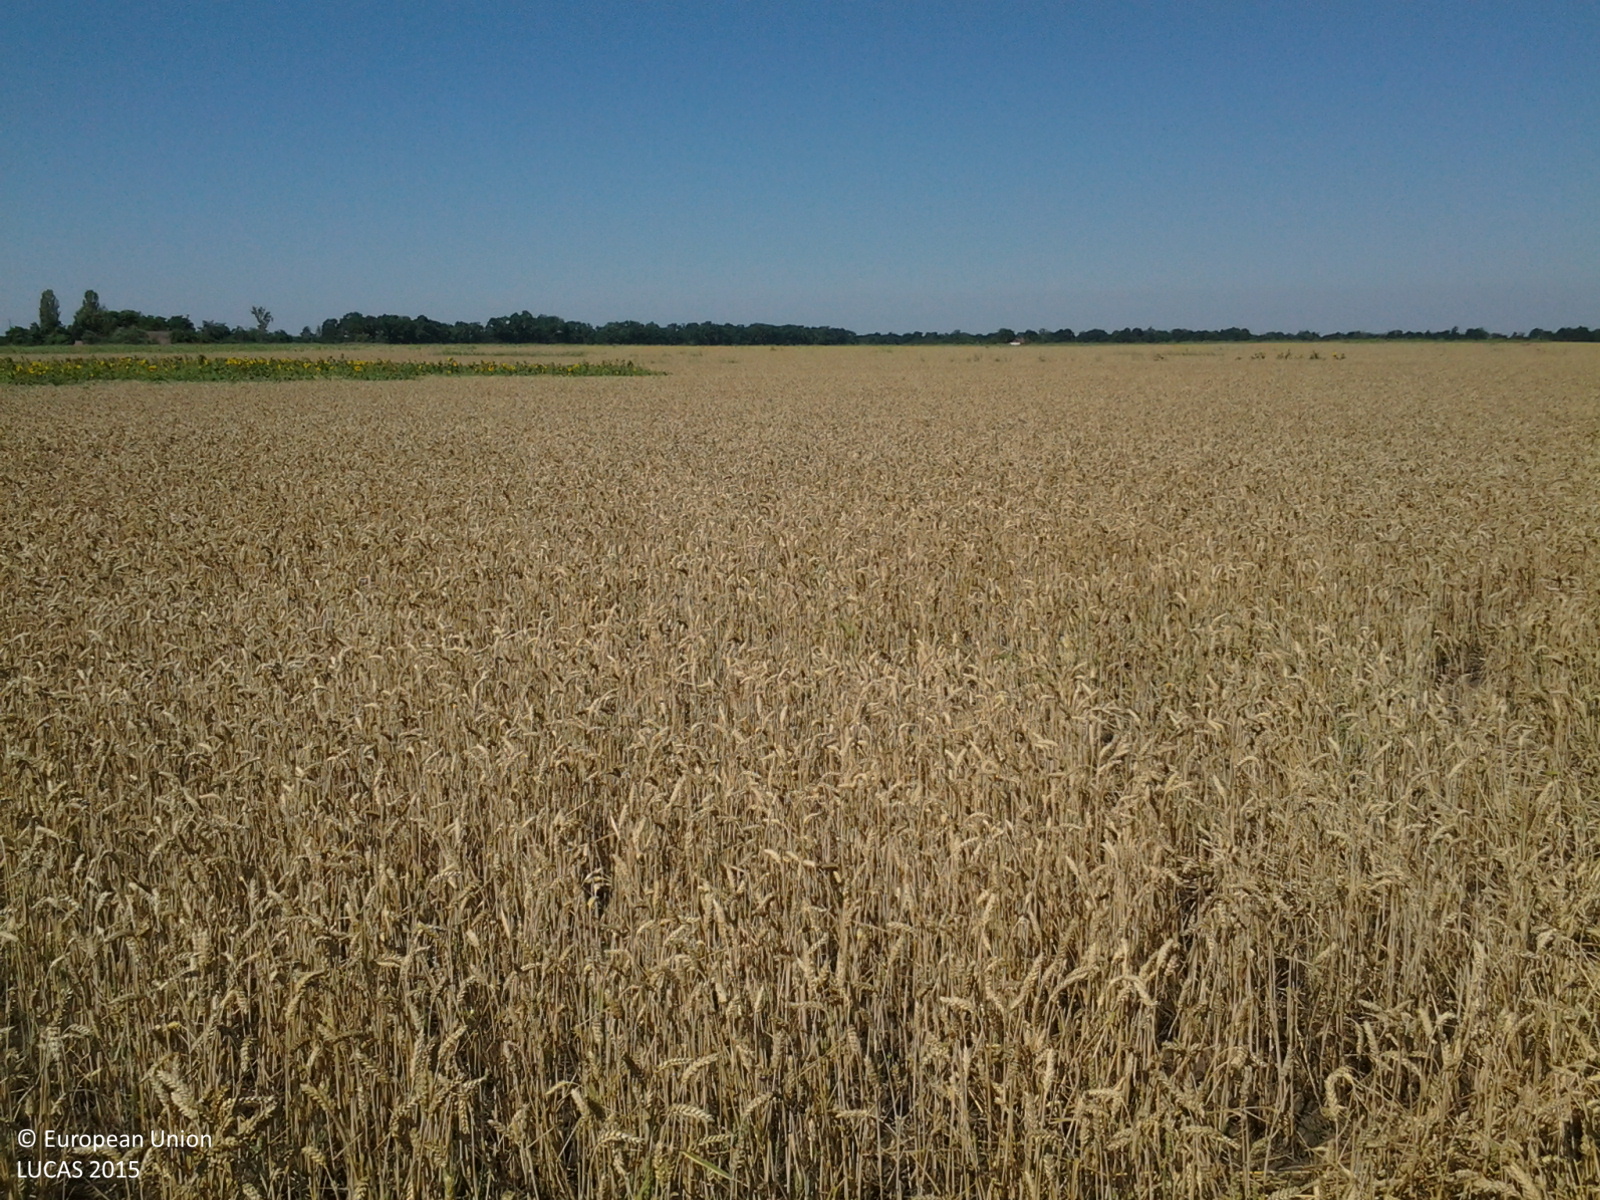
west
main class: Cropland
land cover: Common wheat
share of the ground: > 75 %
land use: Agriculture (excluding fallow land and kitchen gardens)
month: July
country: HU
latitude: 47.0117
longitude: 20.5128
